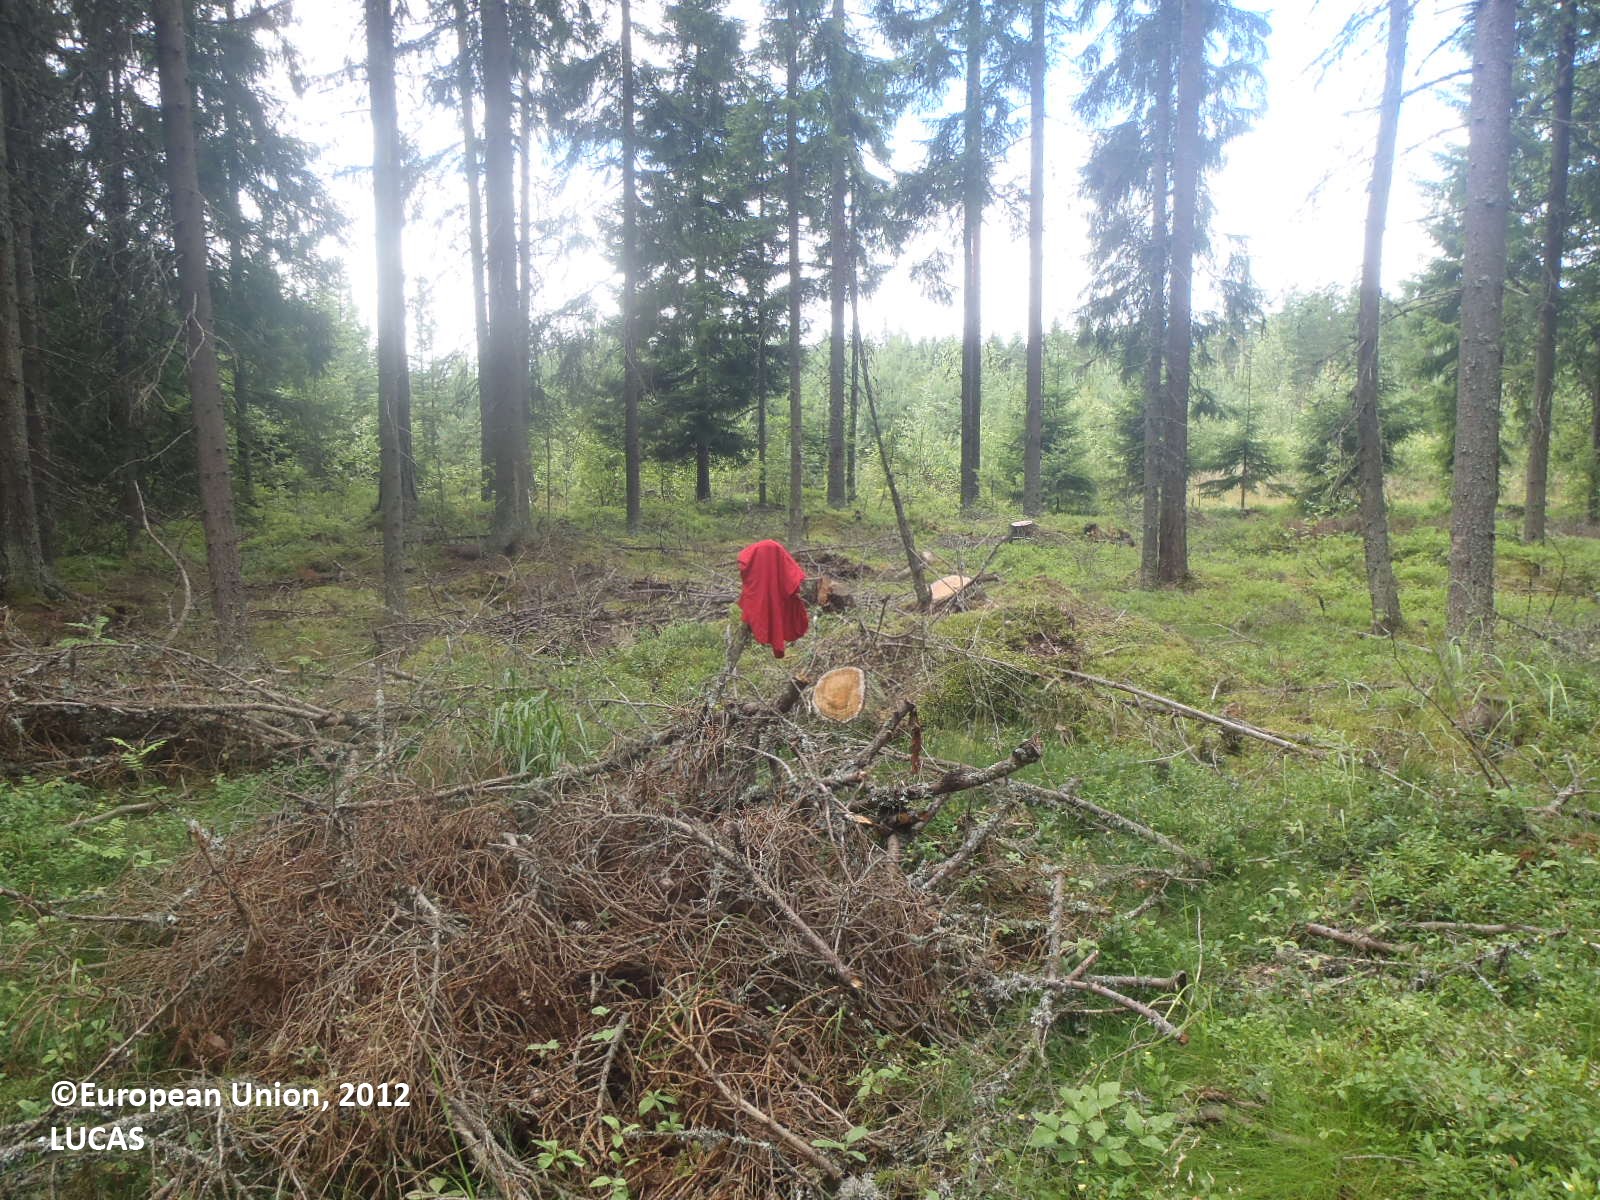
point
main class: Woodland
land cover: Other coniferous woodland
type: boreal forest
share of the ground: 25 - 50 %
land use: Forestry
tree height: > 5 m
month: July
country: FI
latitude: 61.1885
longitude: 21.9064
